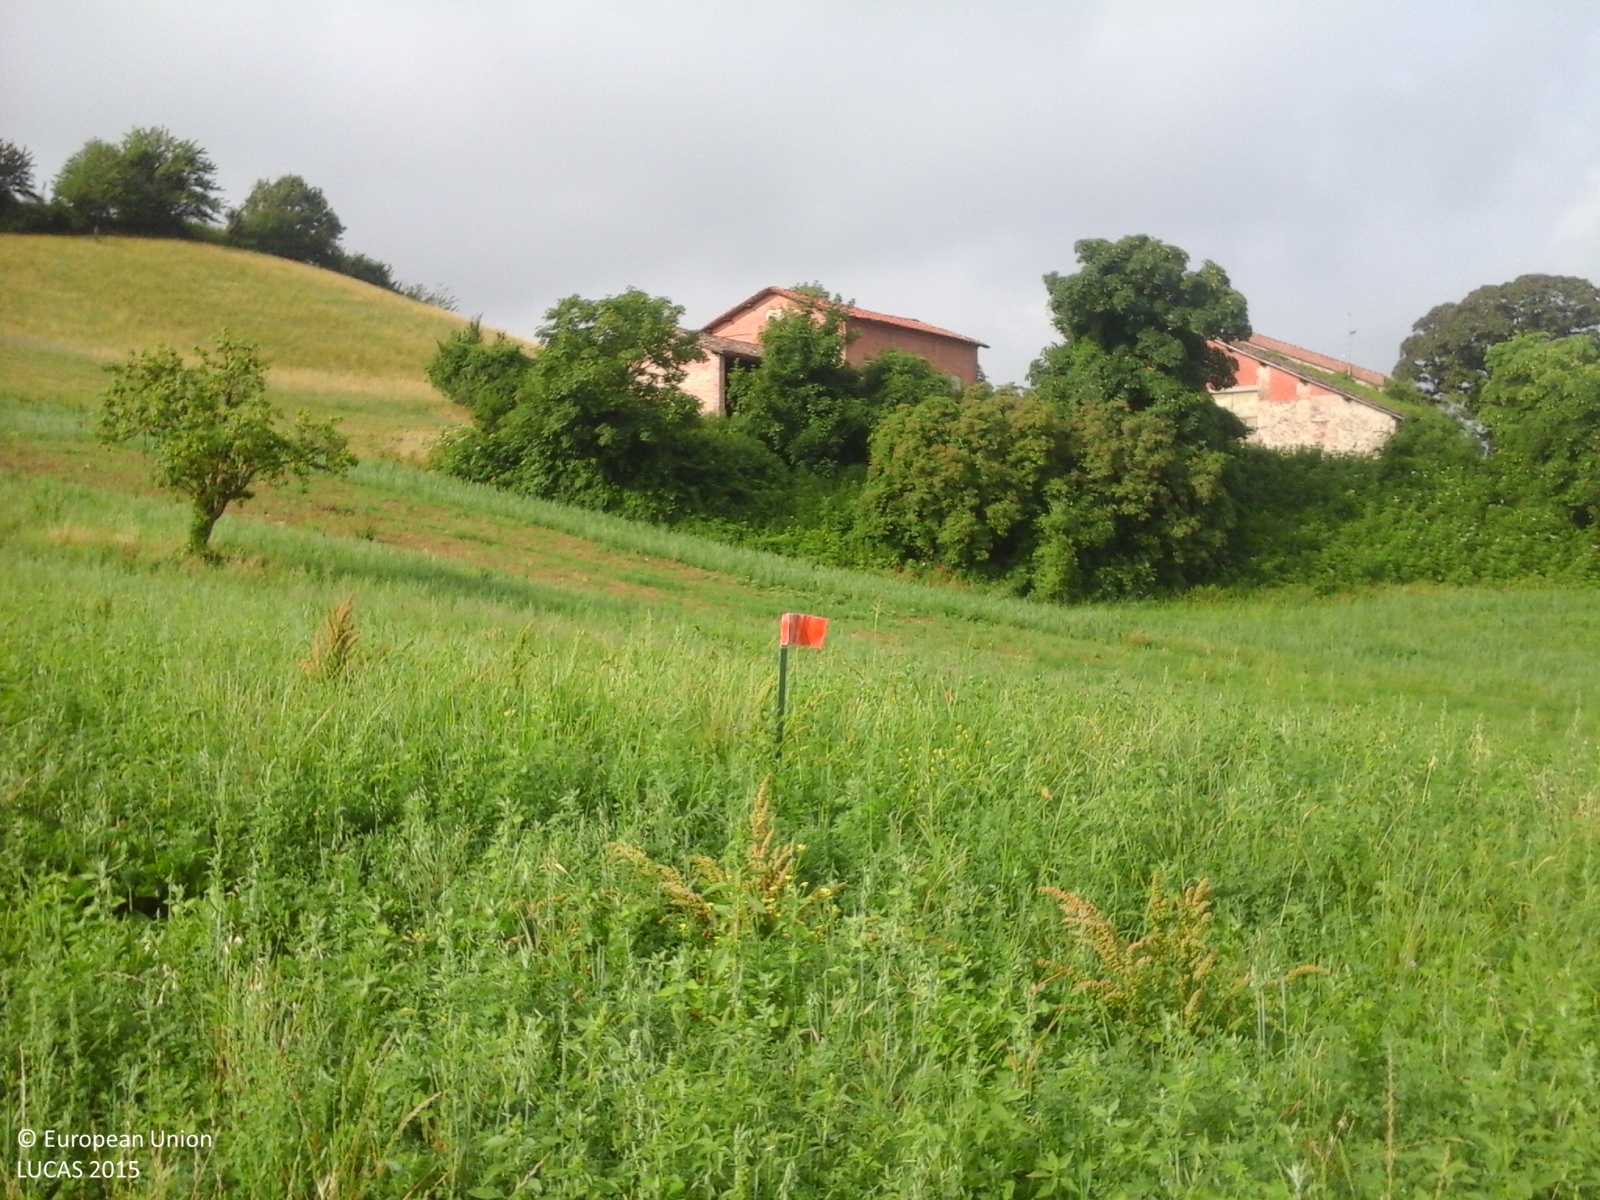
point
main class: Cropland
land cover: Lucerne
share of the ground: > 75 %
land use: Agriculture (excluding fallow land and kitchen gardens)
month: June
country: IT
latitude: 44.6387
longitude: 10.2893
